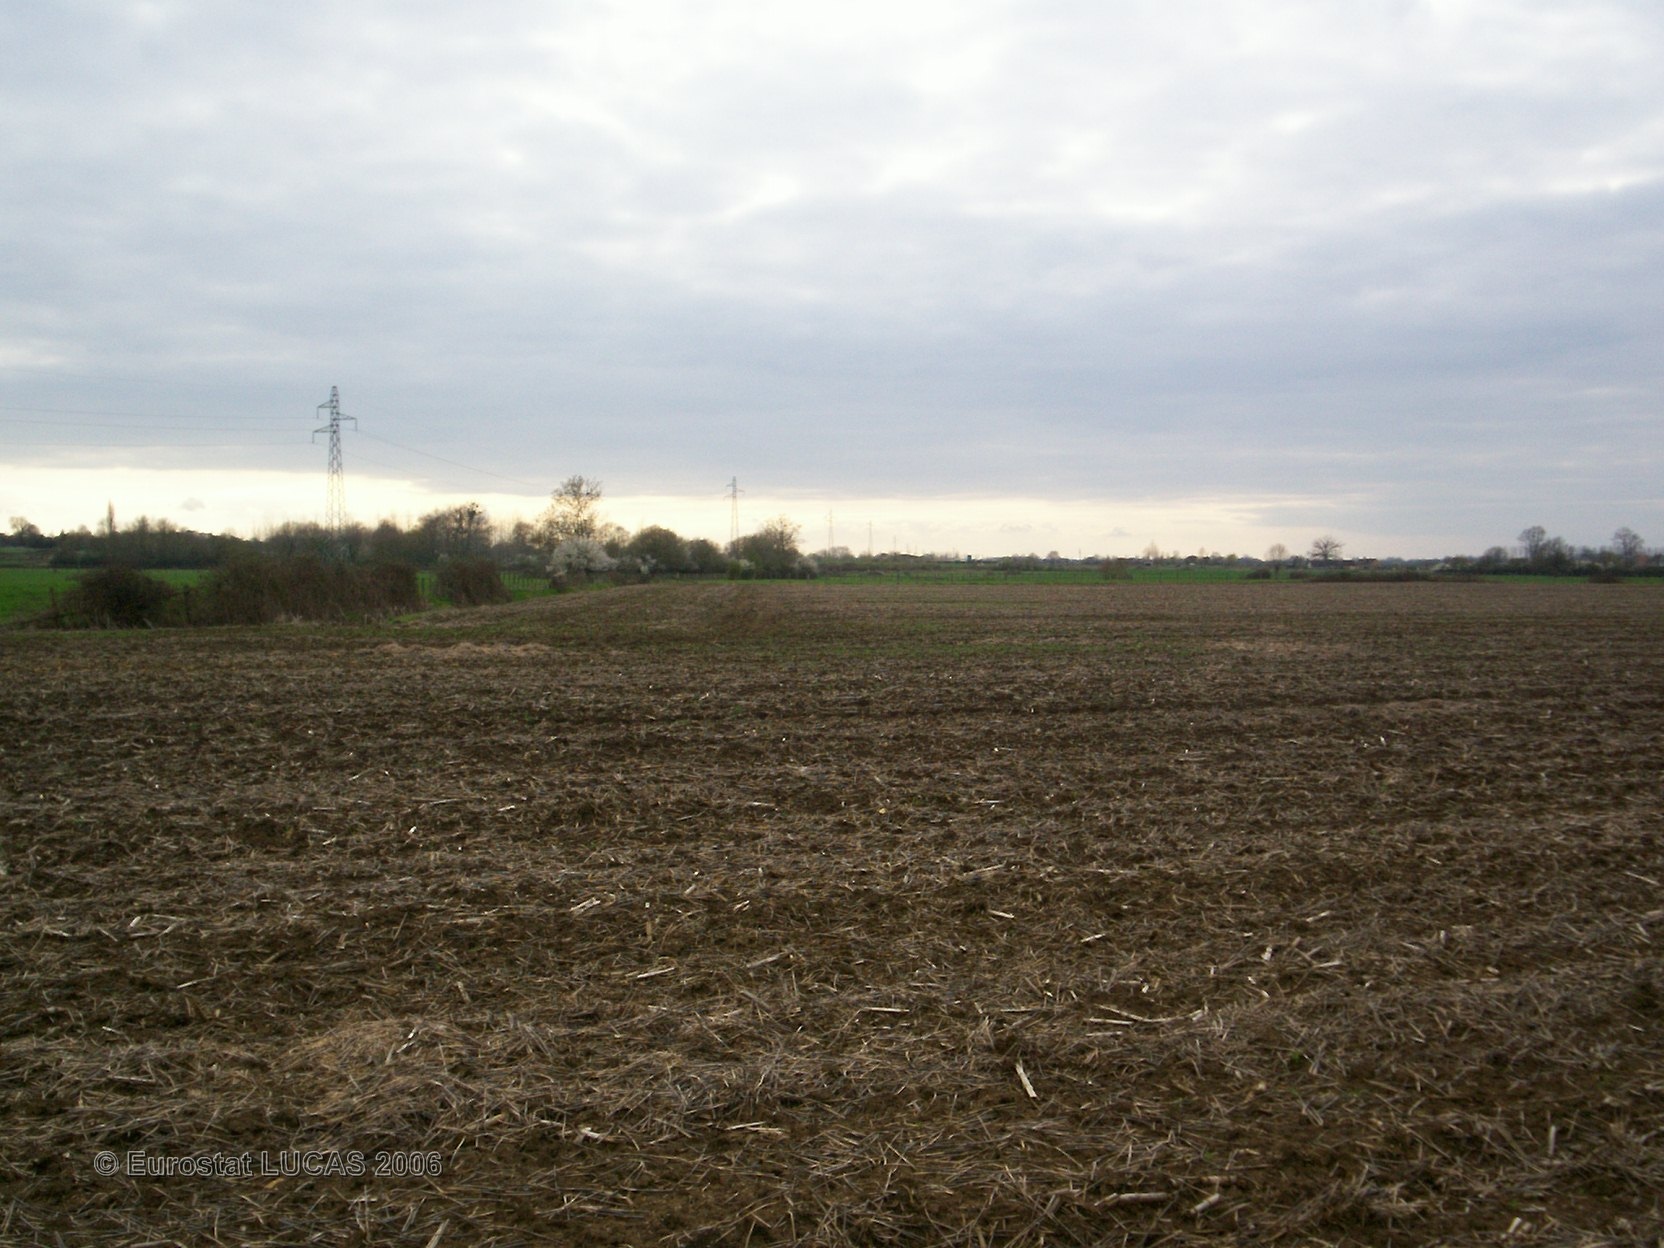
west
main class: Cropland
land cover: Maize
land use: Agriculture (excluding fallow land and kitchen gardens)
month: May
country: FR
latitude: 48.1984
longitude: 0.3550
